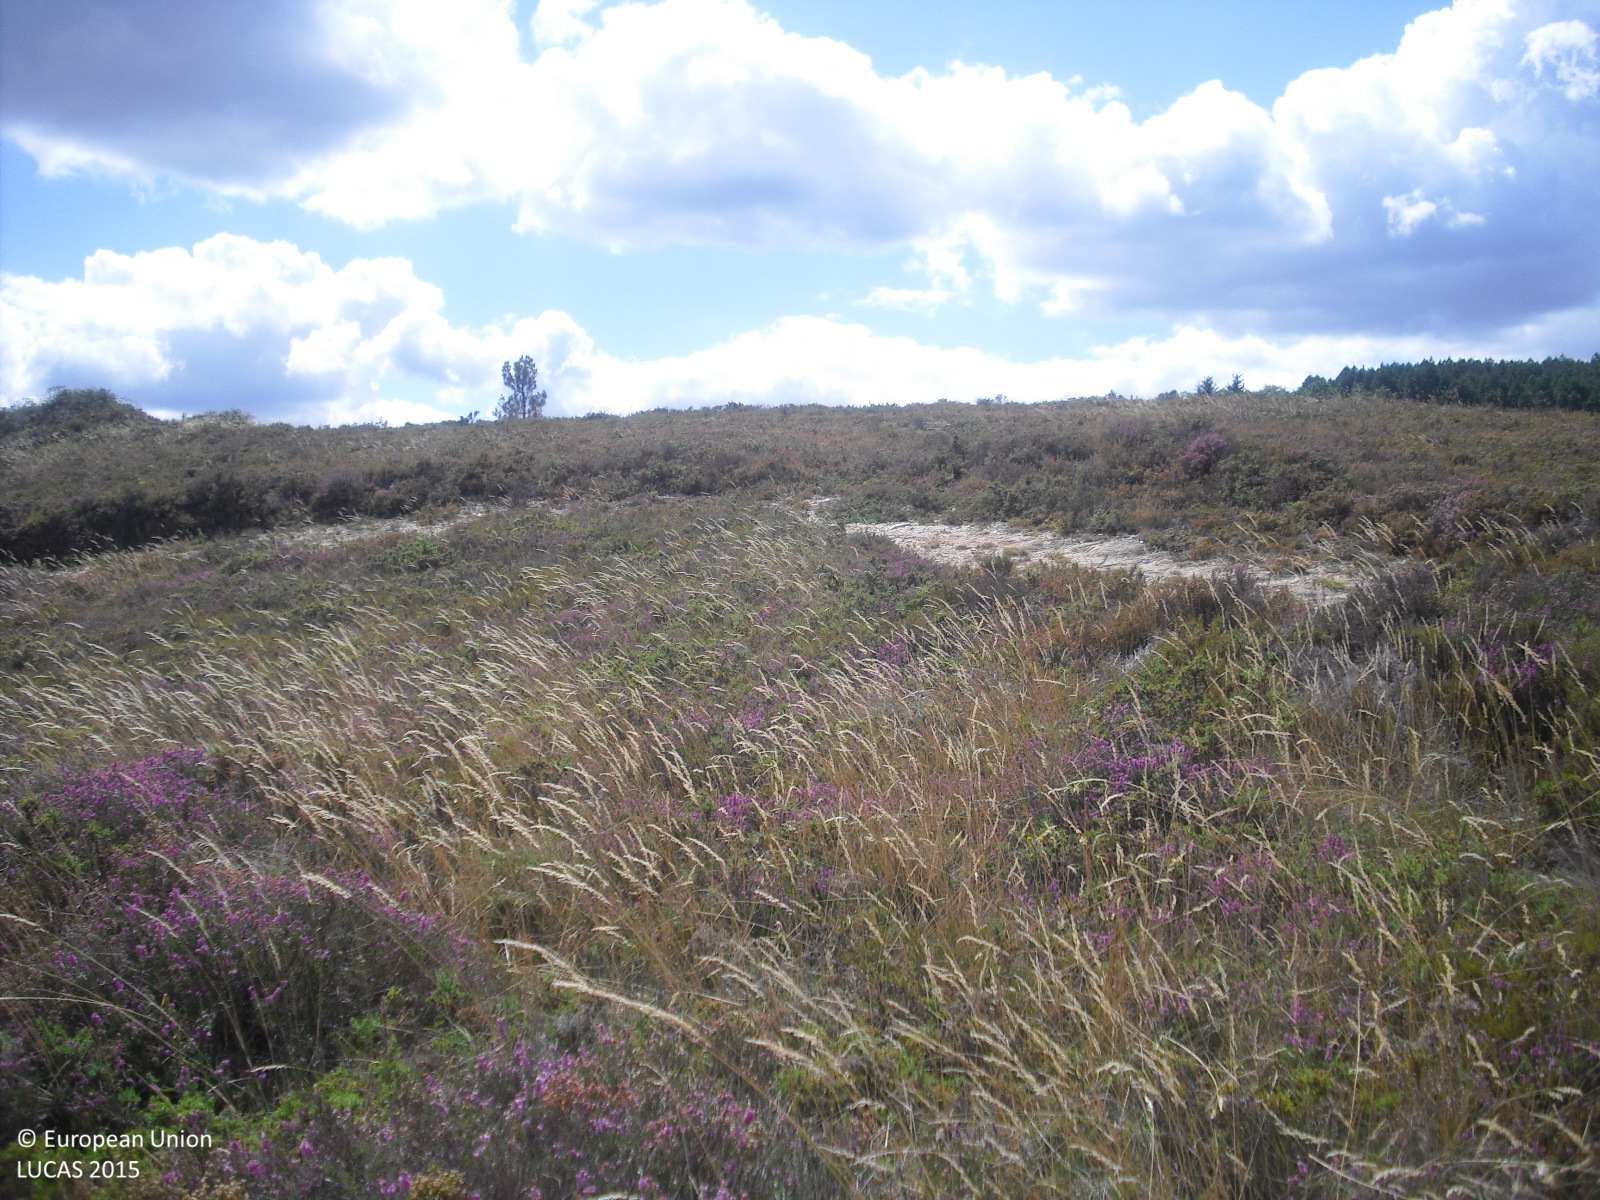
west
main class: Shrubland
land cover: Shrubland without tree cover
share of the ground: > 75 %
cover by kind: shrubs 80 %, unconsolidated bare surface 20 %
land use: Sport
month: July
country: ES
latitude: 42.3594
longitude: -7.6646
